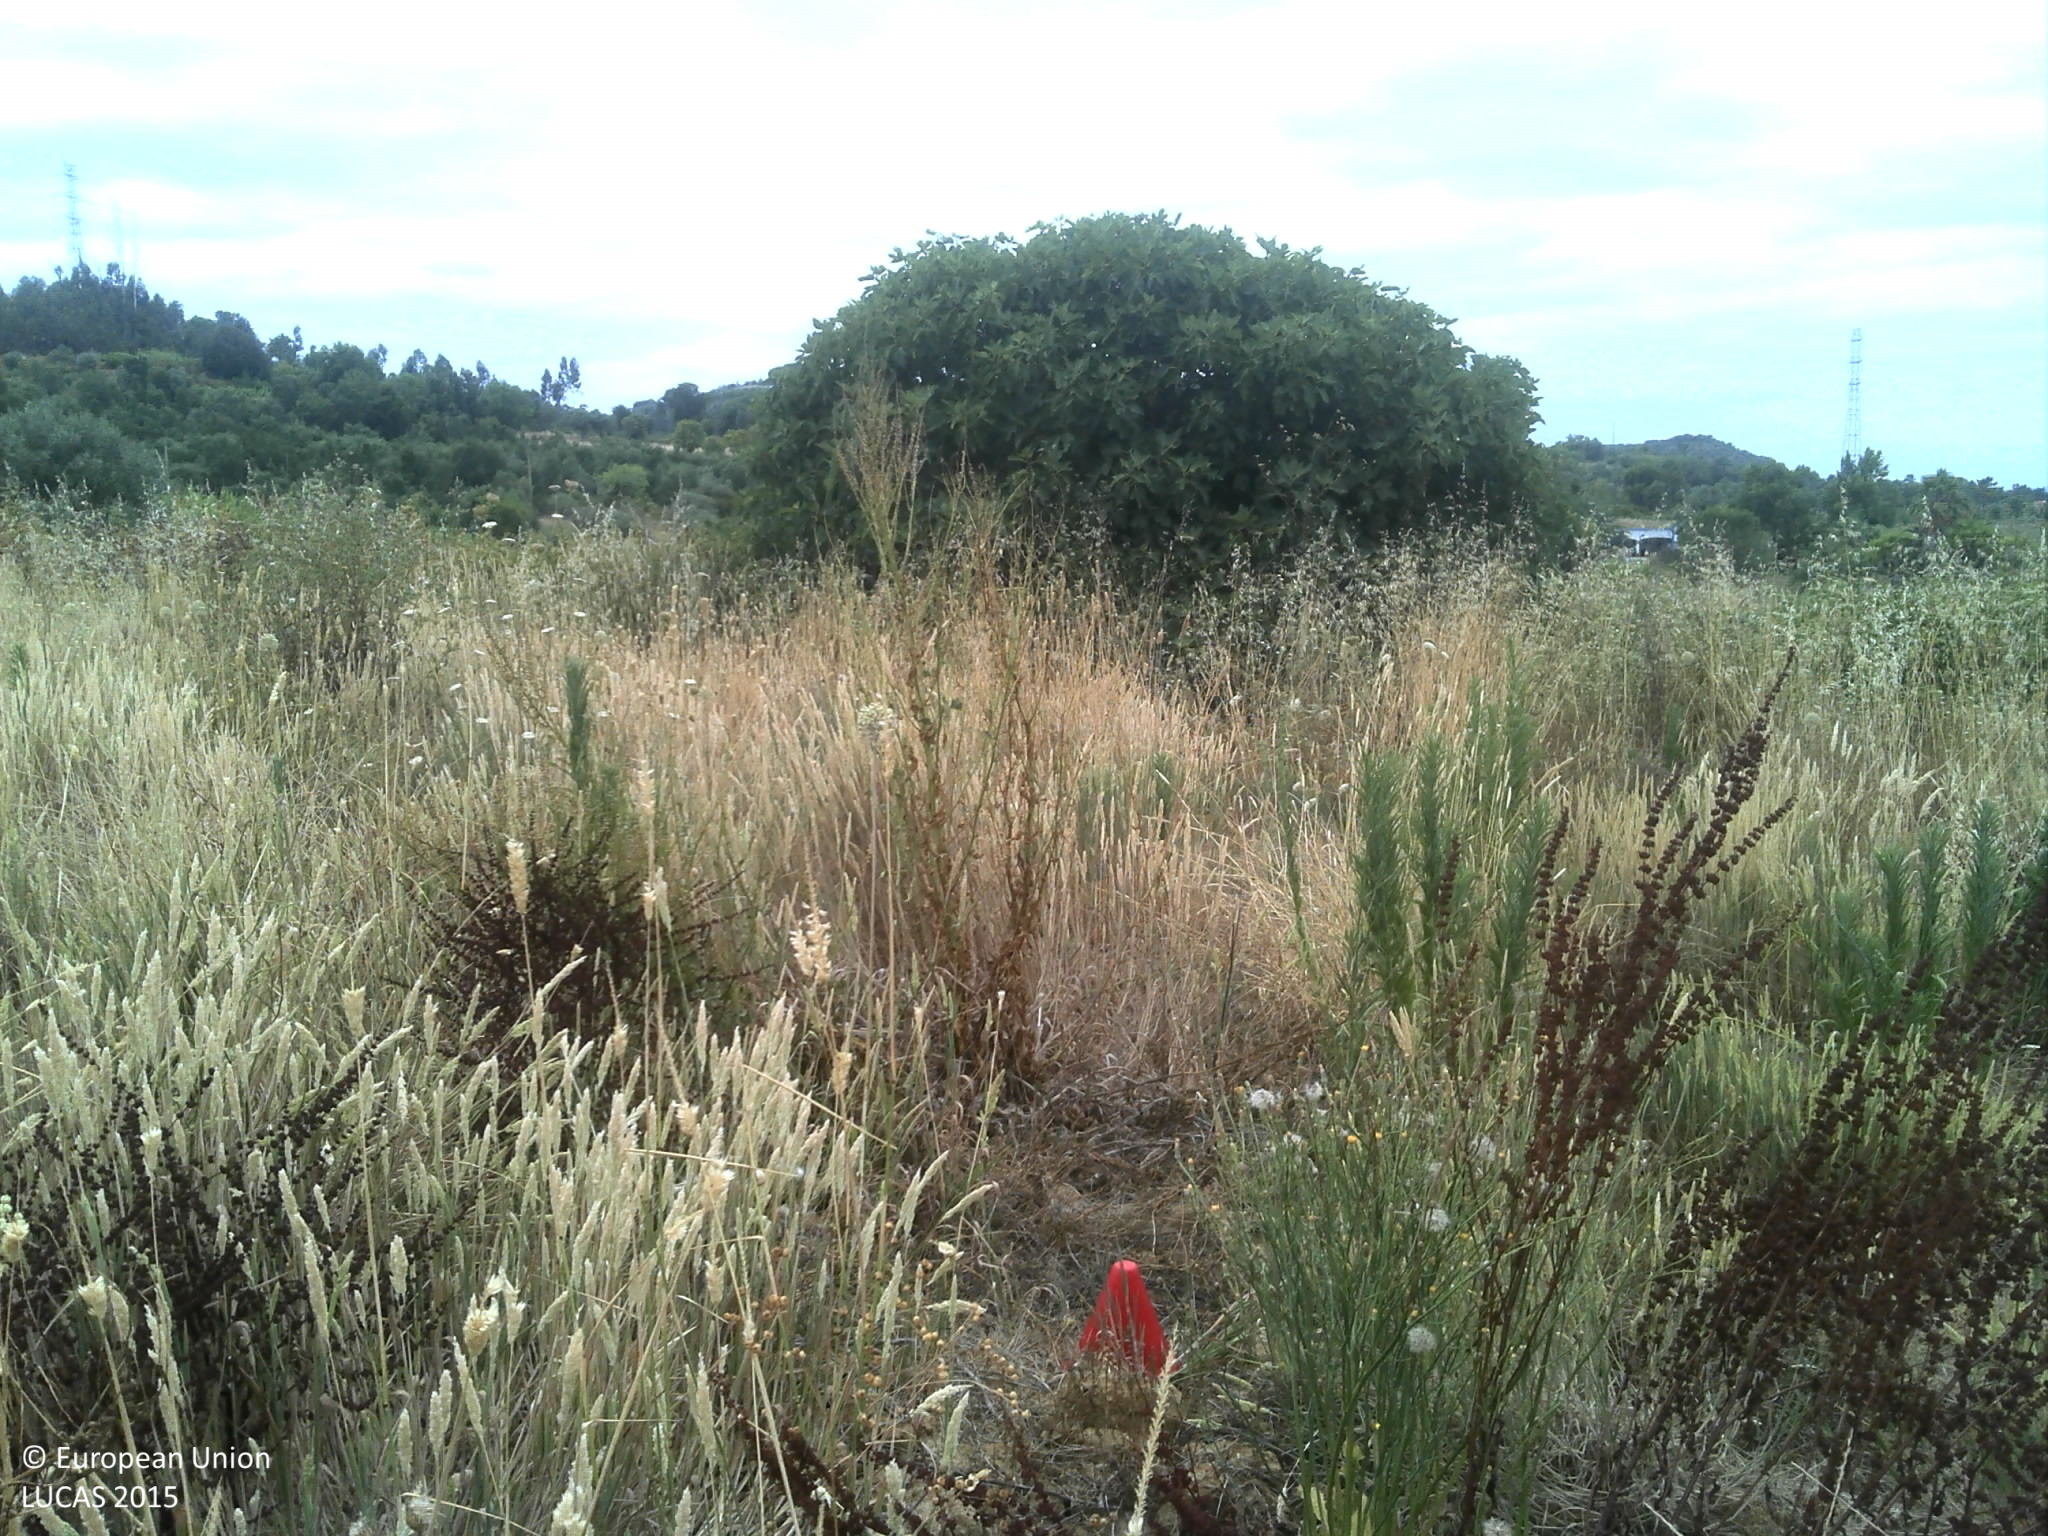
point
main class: Shrubland
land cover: Shrubland without tree cover
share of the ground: 50 - 75 %
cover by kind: shrubs 60 %, unconsolidated bare surface 30 %, herbaceous plants 10 %
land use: Abandoned areas
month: June
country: PT
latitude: 39.2221
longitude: -8.7339
